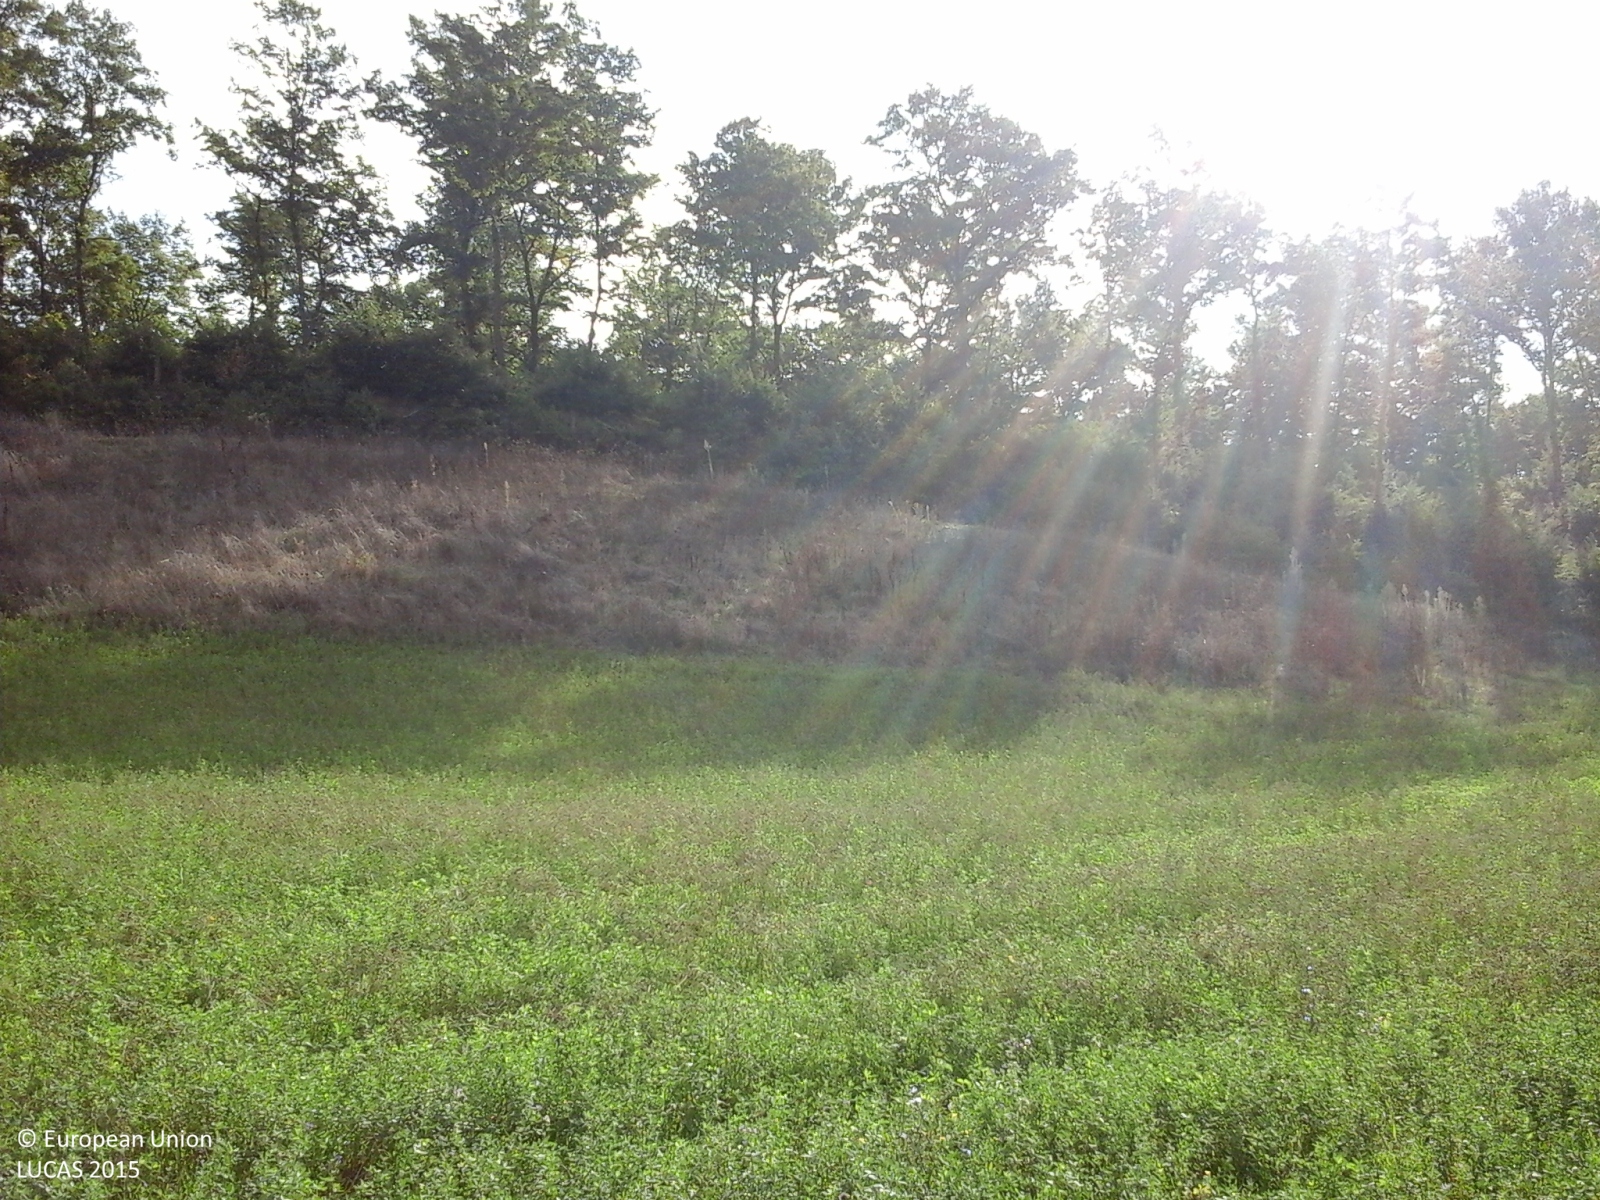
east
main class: Cropland
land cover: Lucerne
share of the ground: > 75 %
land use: Agriculture (excluding fallow land and kitchen gardens)
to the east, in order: Lucerne; Grassland without tree/shrub cover; Tracks; Broadleaved woodland; Tracks; Broadleaved woodland
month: October
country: IT
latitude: 43.2880
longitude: 12.6425
